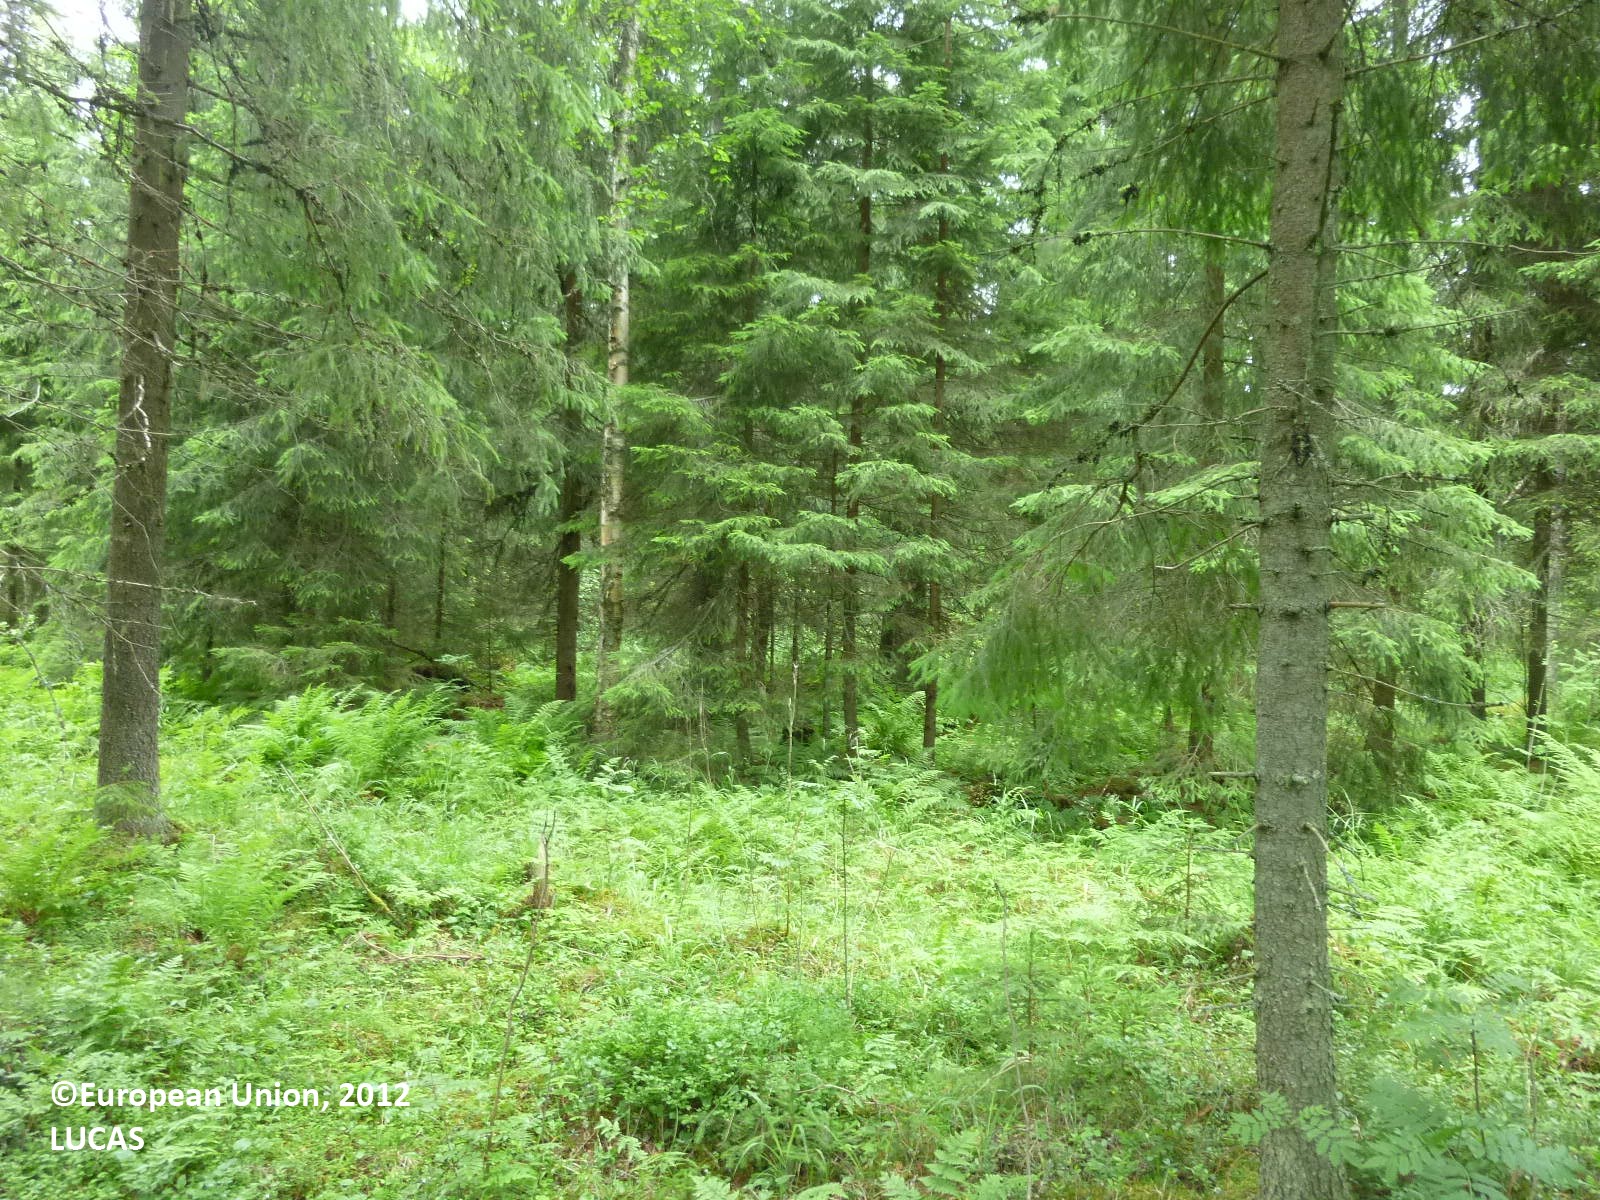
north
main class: Woodland
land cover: Spruce dominated coniferous woodland
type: boreal forest
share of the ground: > 75 %
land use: Forestry
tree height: > 5 m
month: July
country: FI
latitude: 61.7020
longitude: 22.1017
